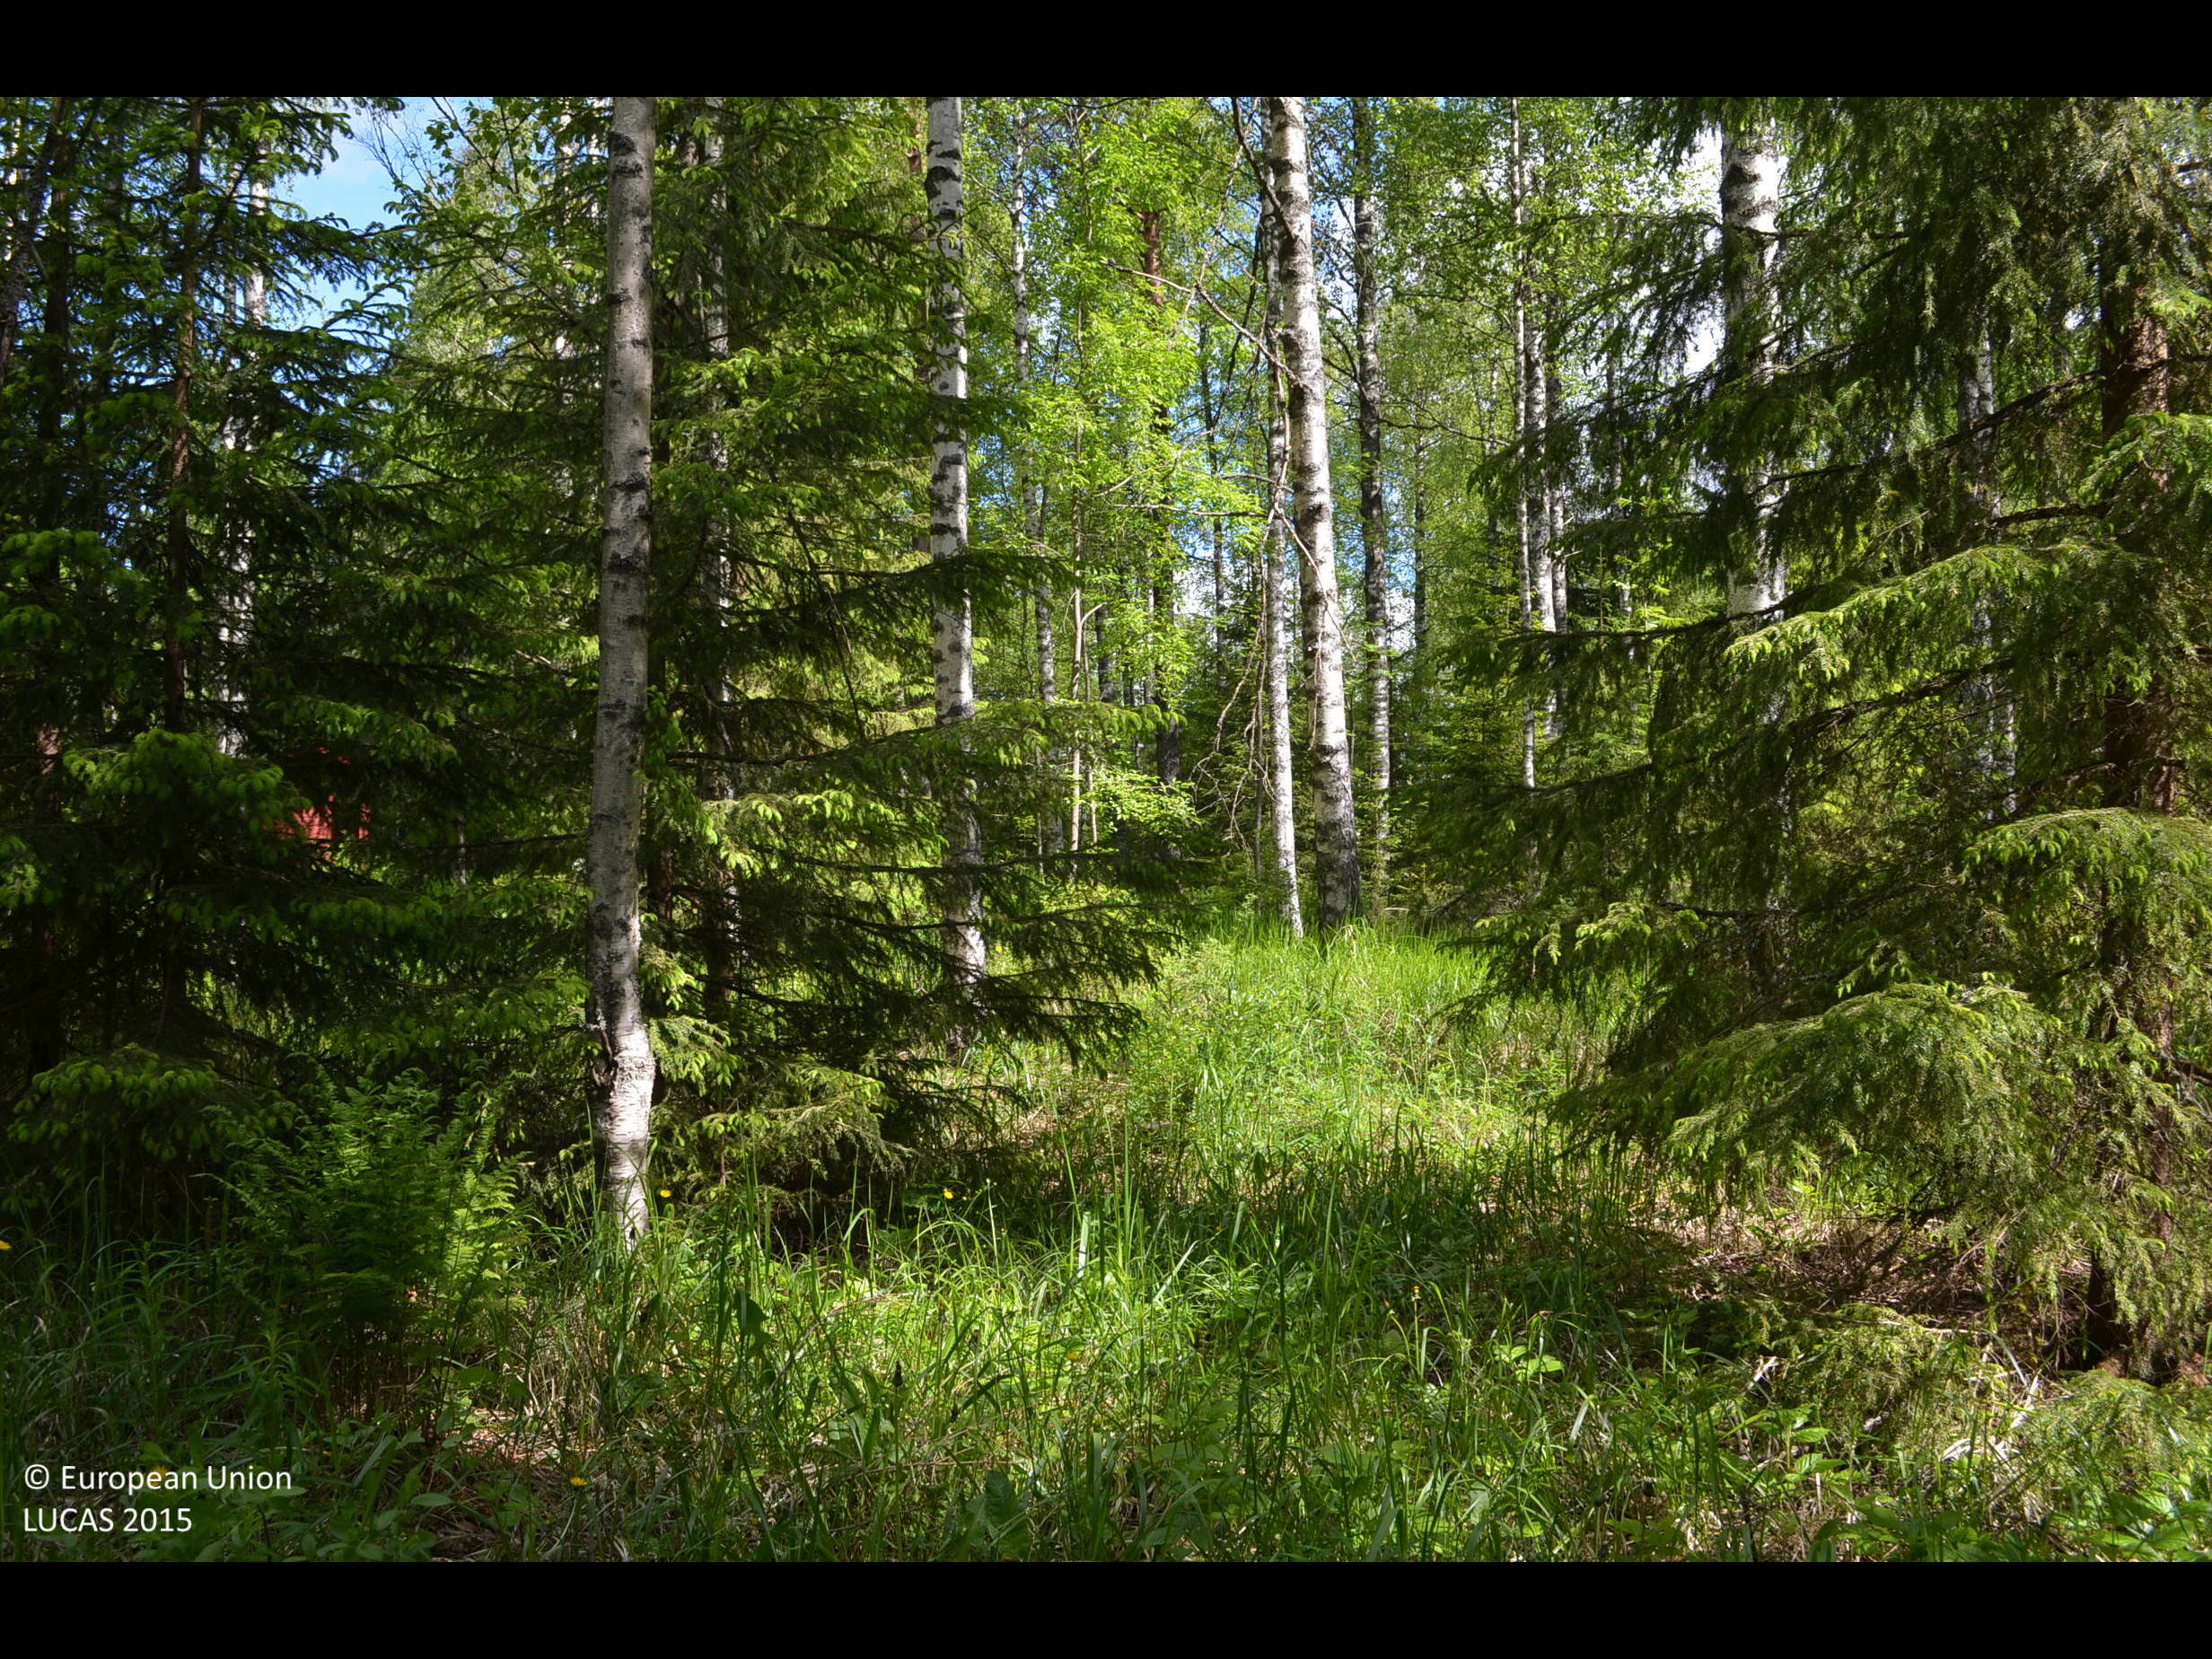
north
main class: Woodland
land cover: Spruce dominated mixed woodland
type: boreal forest
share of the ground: > 75 %
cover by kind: coniferous forest trees 40 %, broadleaved forest trees 40 %, herbaceous plants 20 %
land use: Forestry
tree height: > 5 m
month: June
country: FI
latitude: 61.9622
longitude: 23.5205
